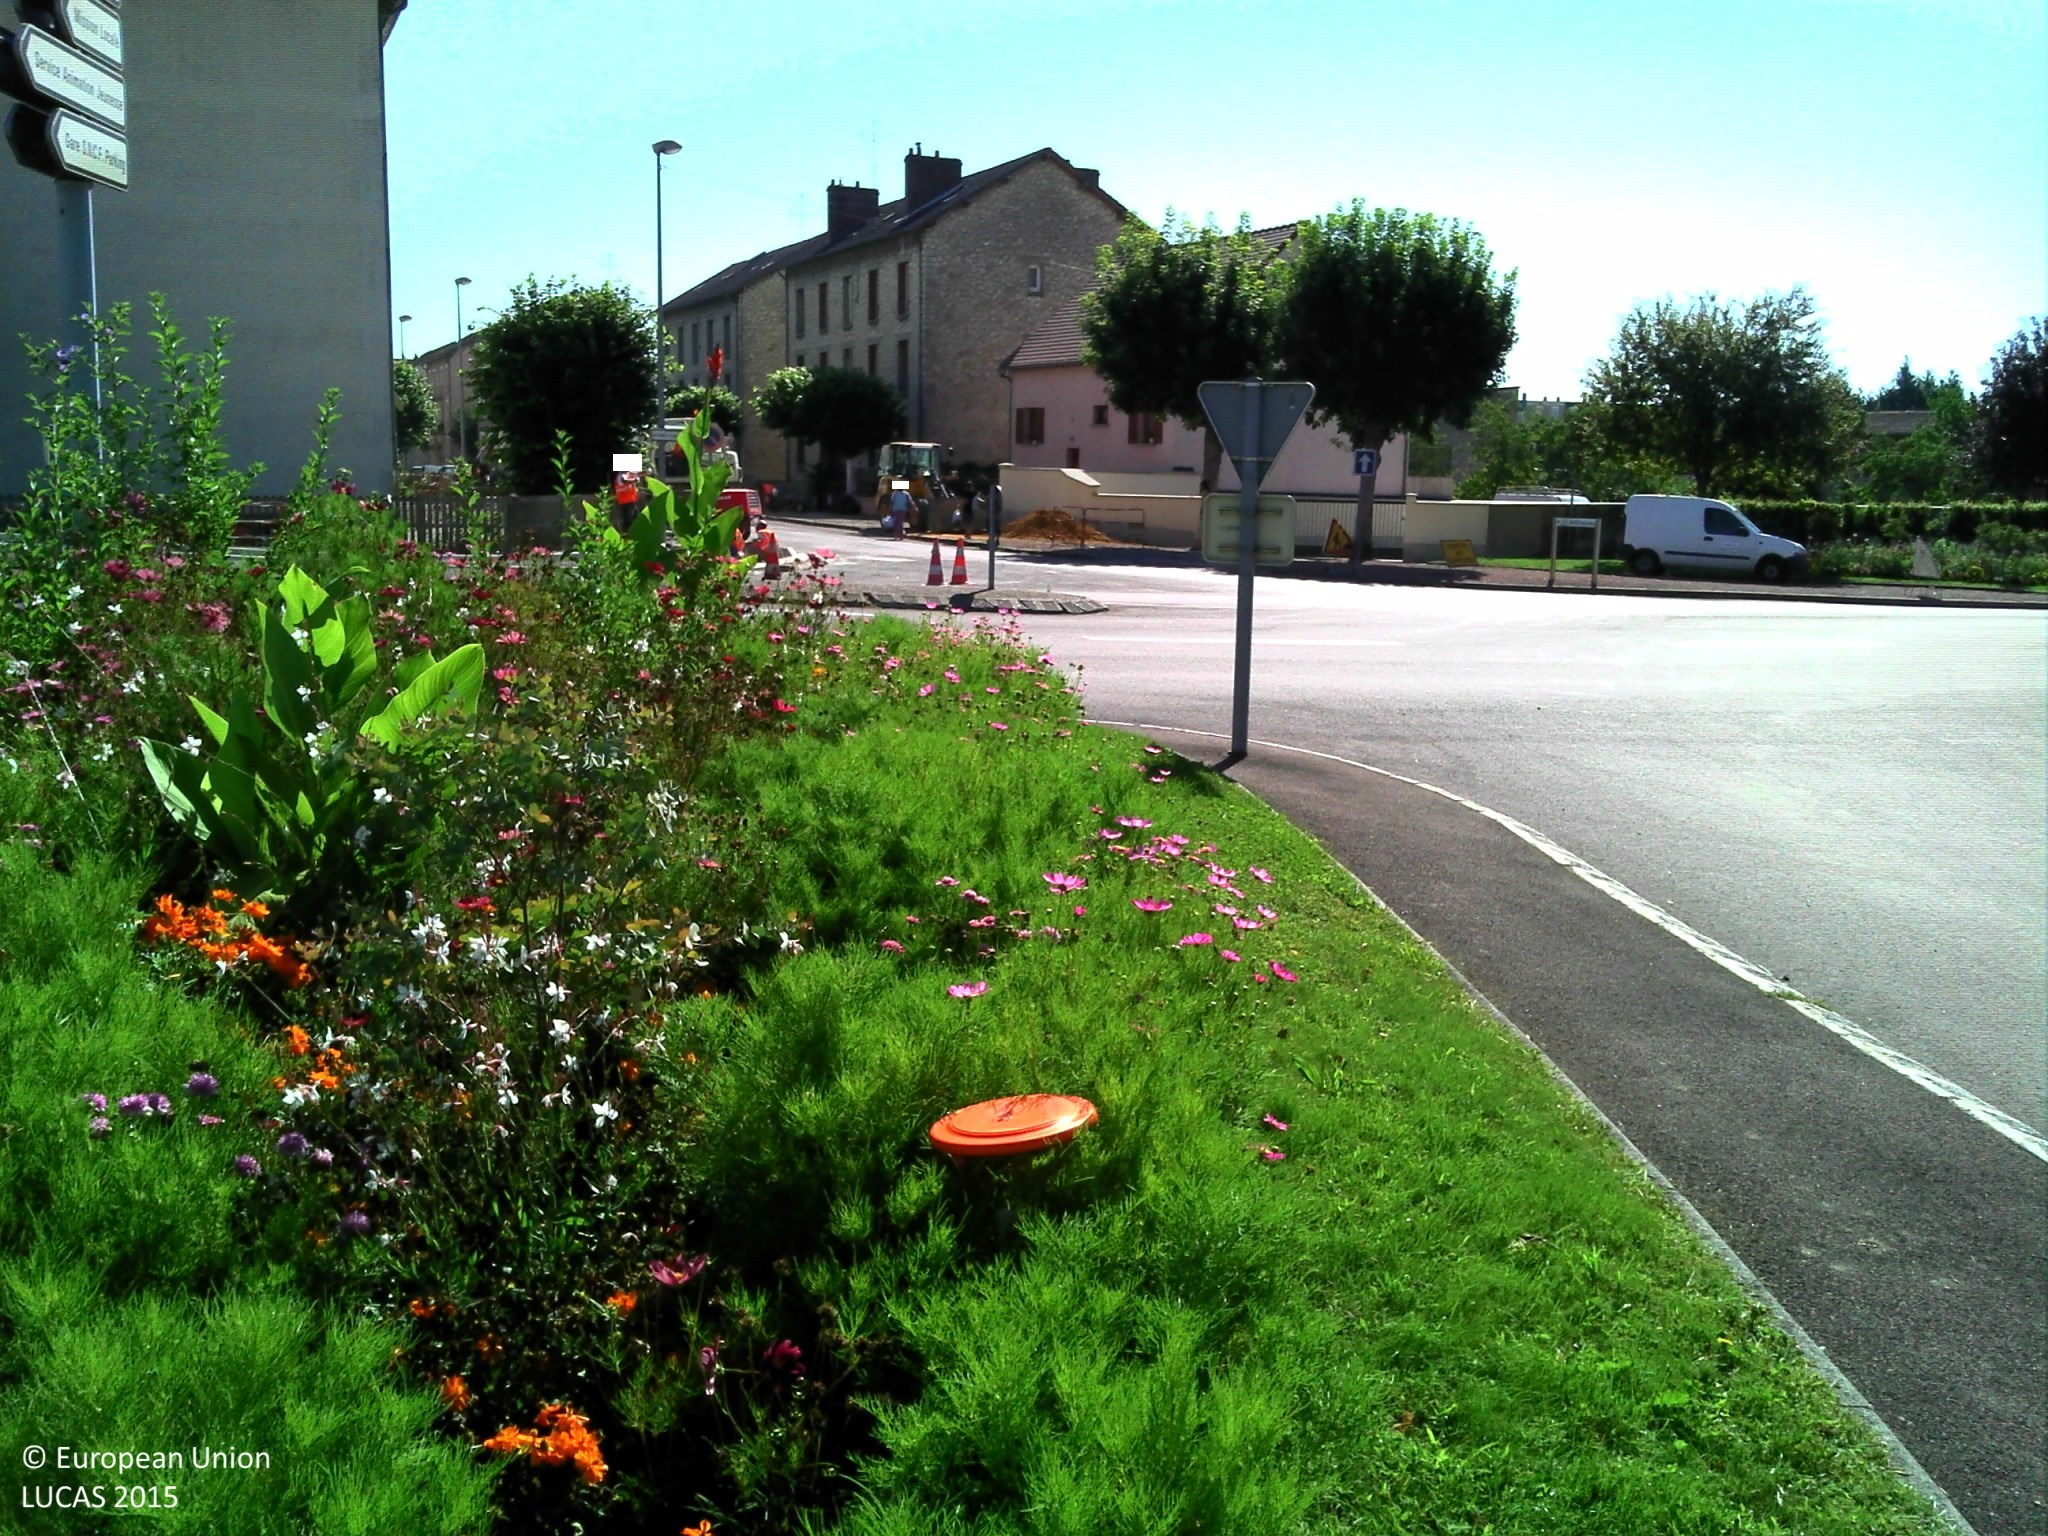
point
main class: Cropland
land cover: Floriculture and ornamental plants
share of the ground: > 75 %
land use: Community services
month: August
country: FR
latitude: 47.9610
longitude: 3.5266
